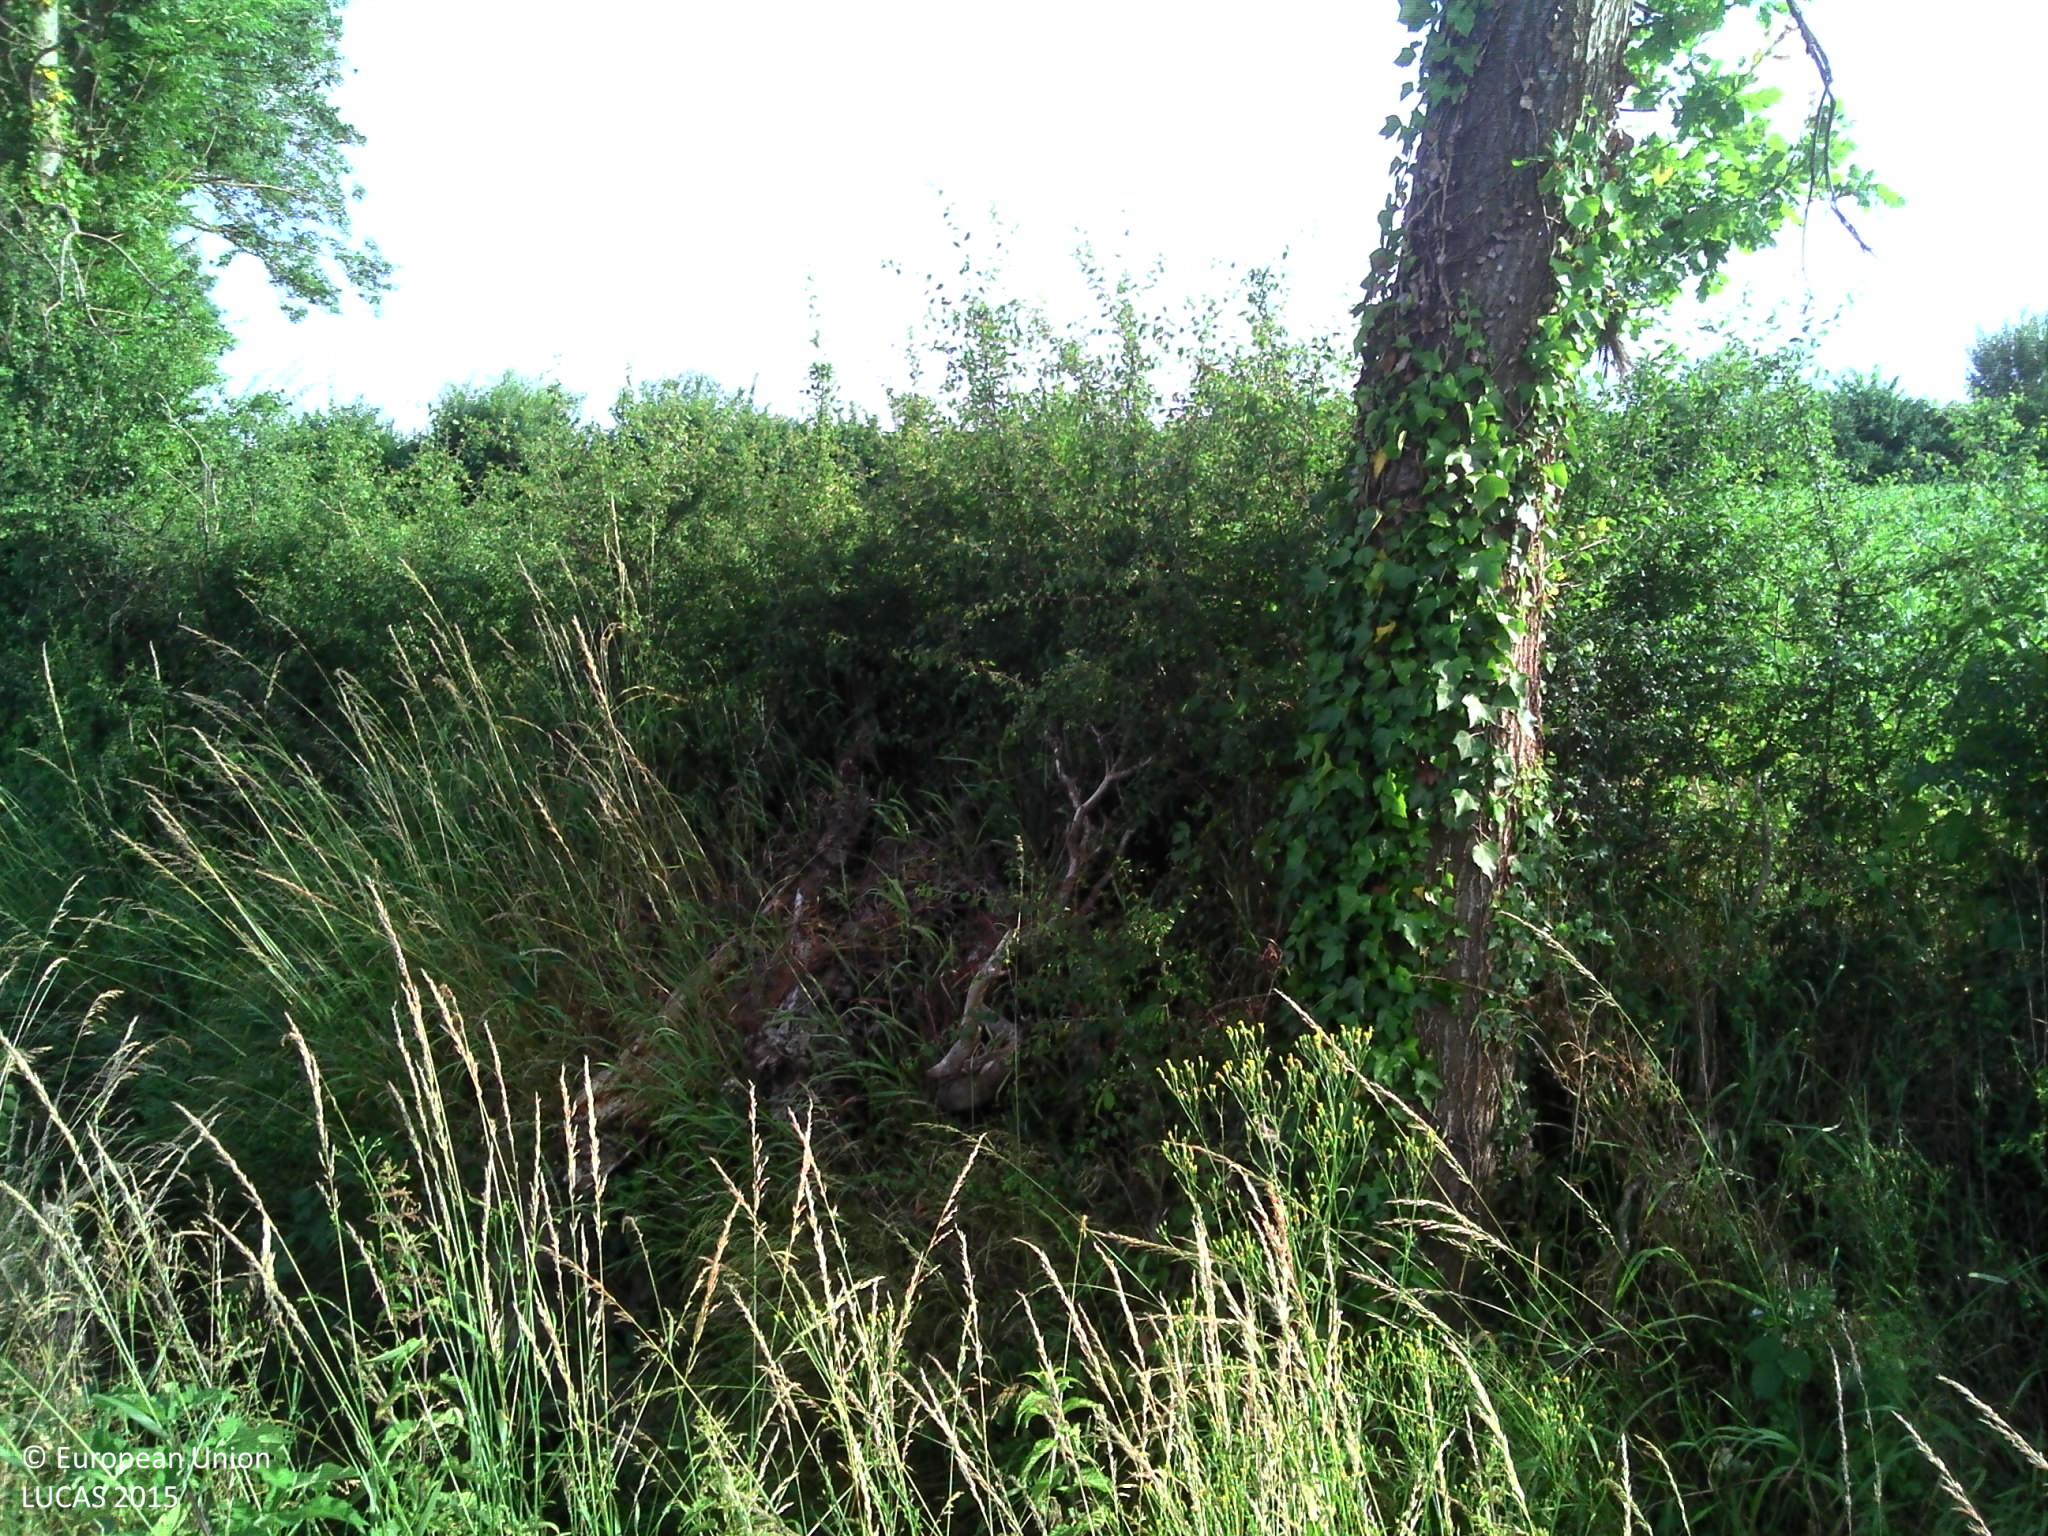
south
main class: Cropland
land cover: Maize
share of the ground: 25 - 50 %
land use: Agriculture (excluding fallow land and kitchen gardens)
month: June
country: FR
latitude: 46.0453
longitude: 4.8208
